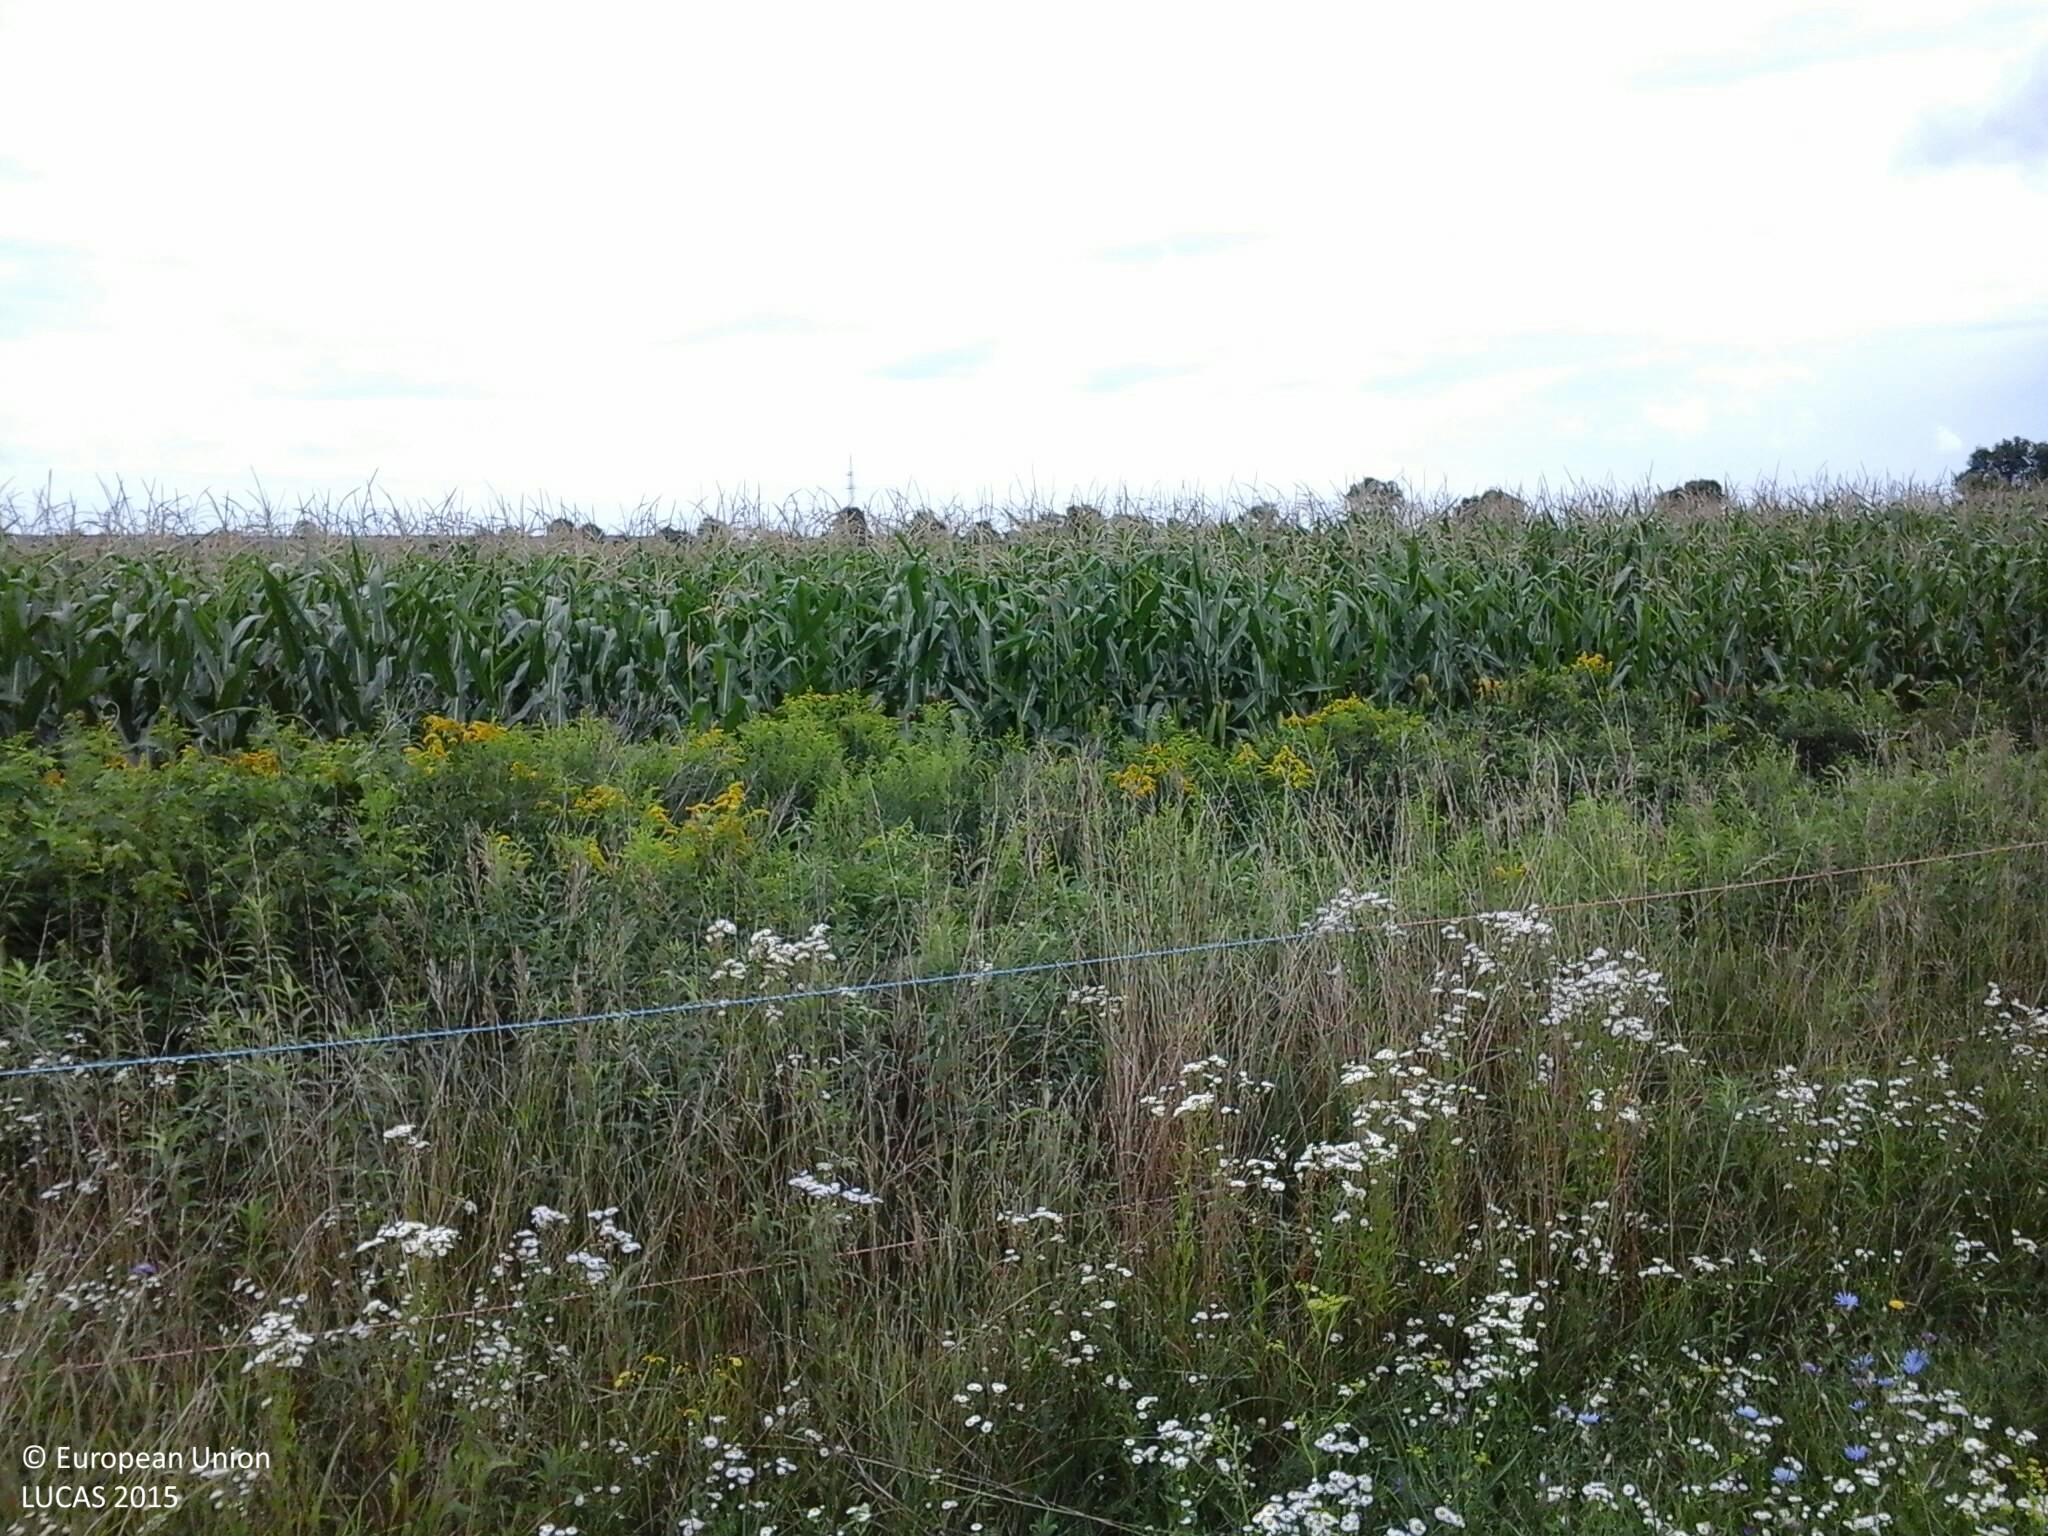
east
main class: Grassland
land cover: Grassland without tree/shrub cover
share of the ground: > 75 %
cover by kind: herbaceous plants 100 %
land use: Agriculture (excluding fallow land and kitchen gardens)
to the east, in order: Grassland without tree/shrub cover; Fences; Spontaneously vegetated surfaces; Maize; Arable land (only in case pi)
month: July
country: HU
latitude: 46.7507
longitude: 16.4816
